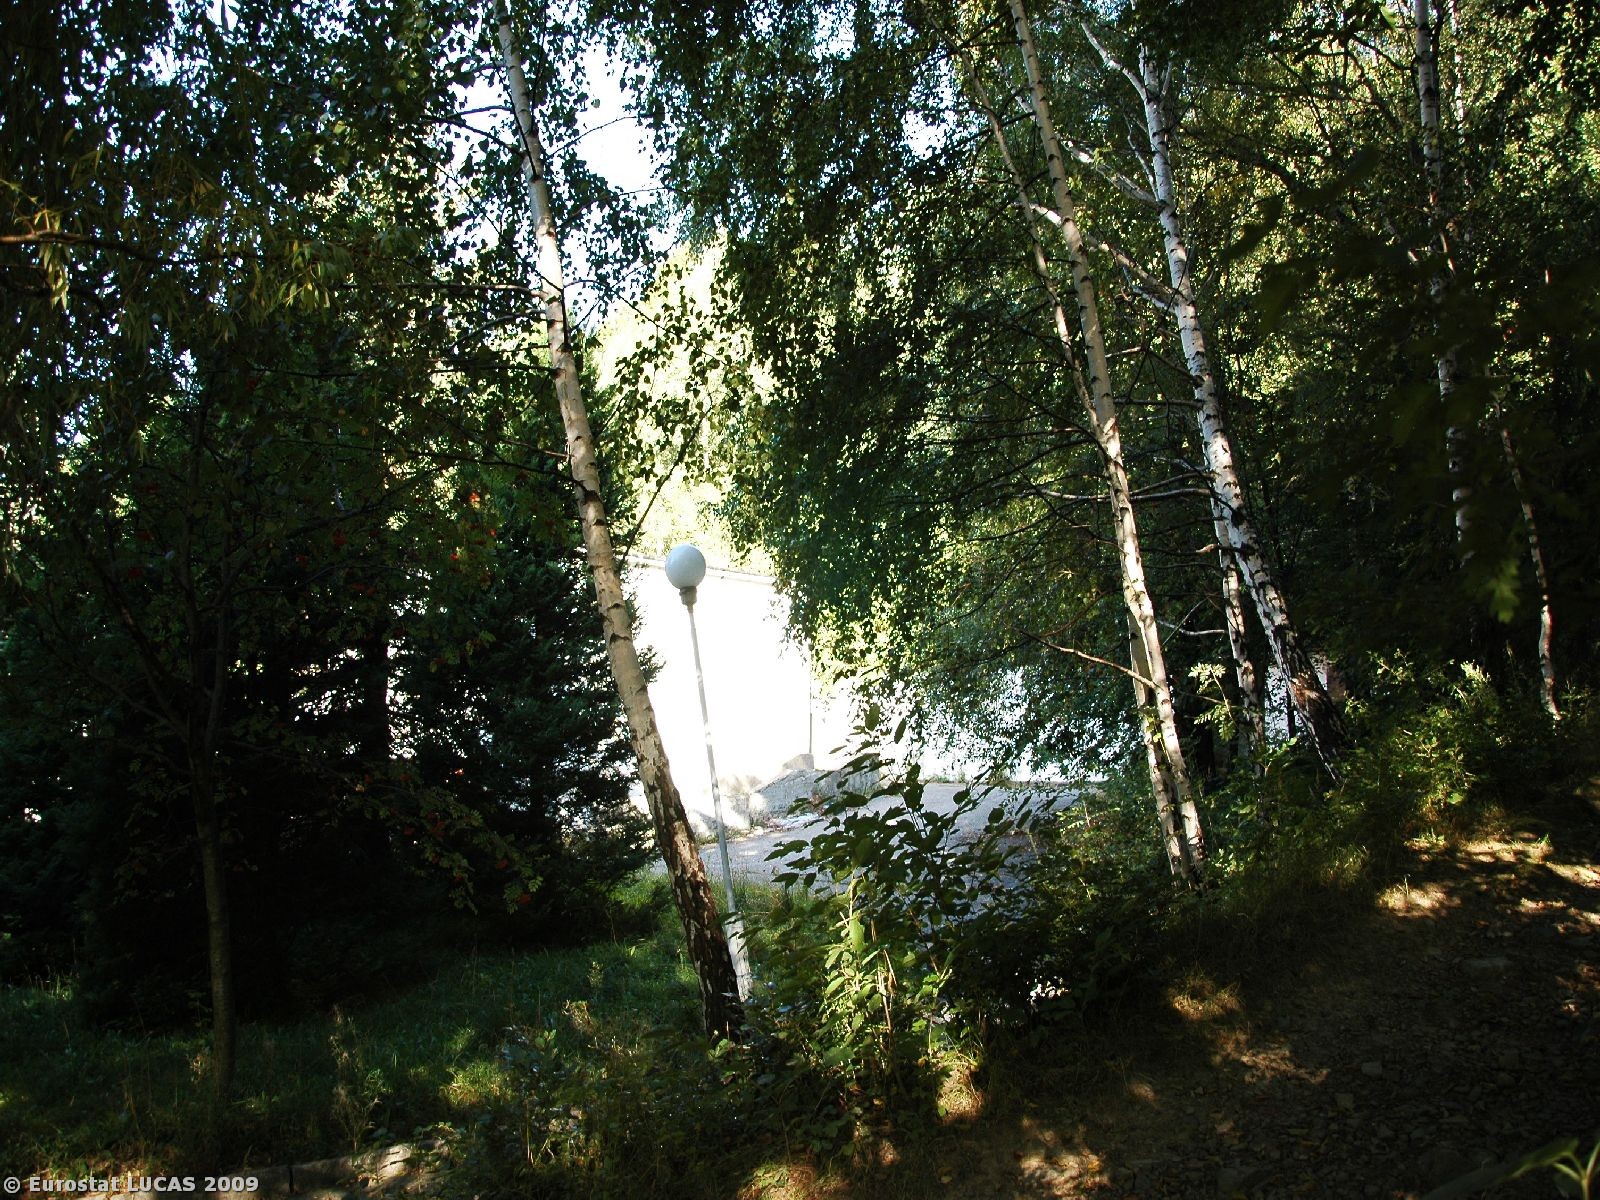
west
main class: Woodland
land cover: Broadleaved woodland
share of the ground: > 75 %
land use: Unused
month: September
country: PL
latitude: 49.7172
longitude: 19.0242
